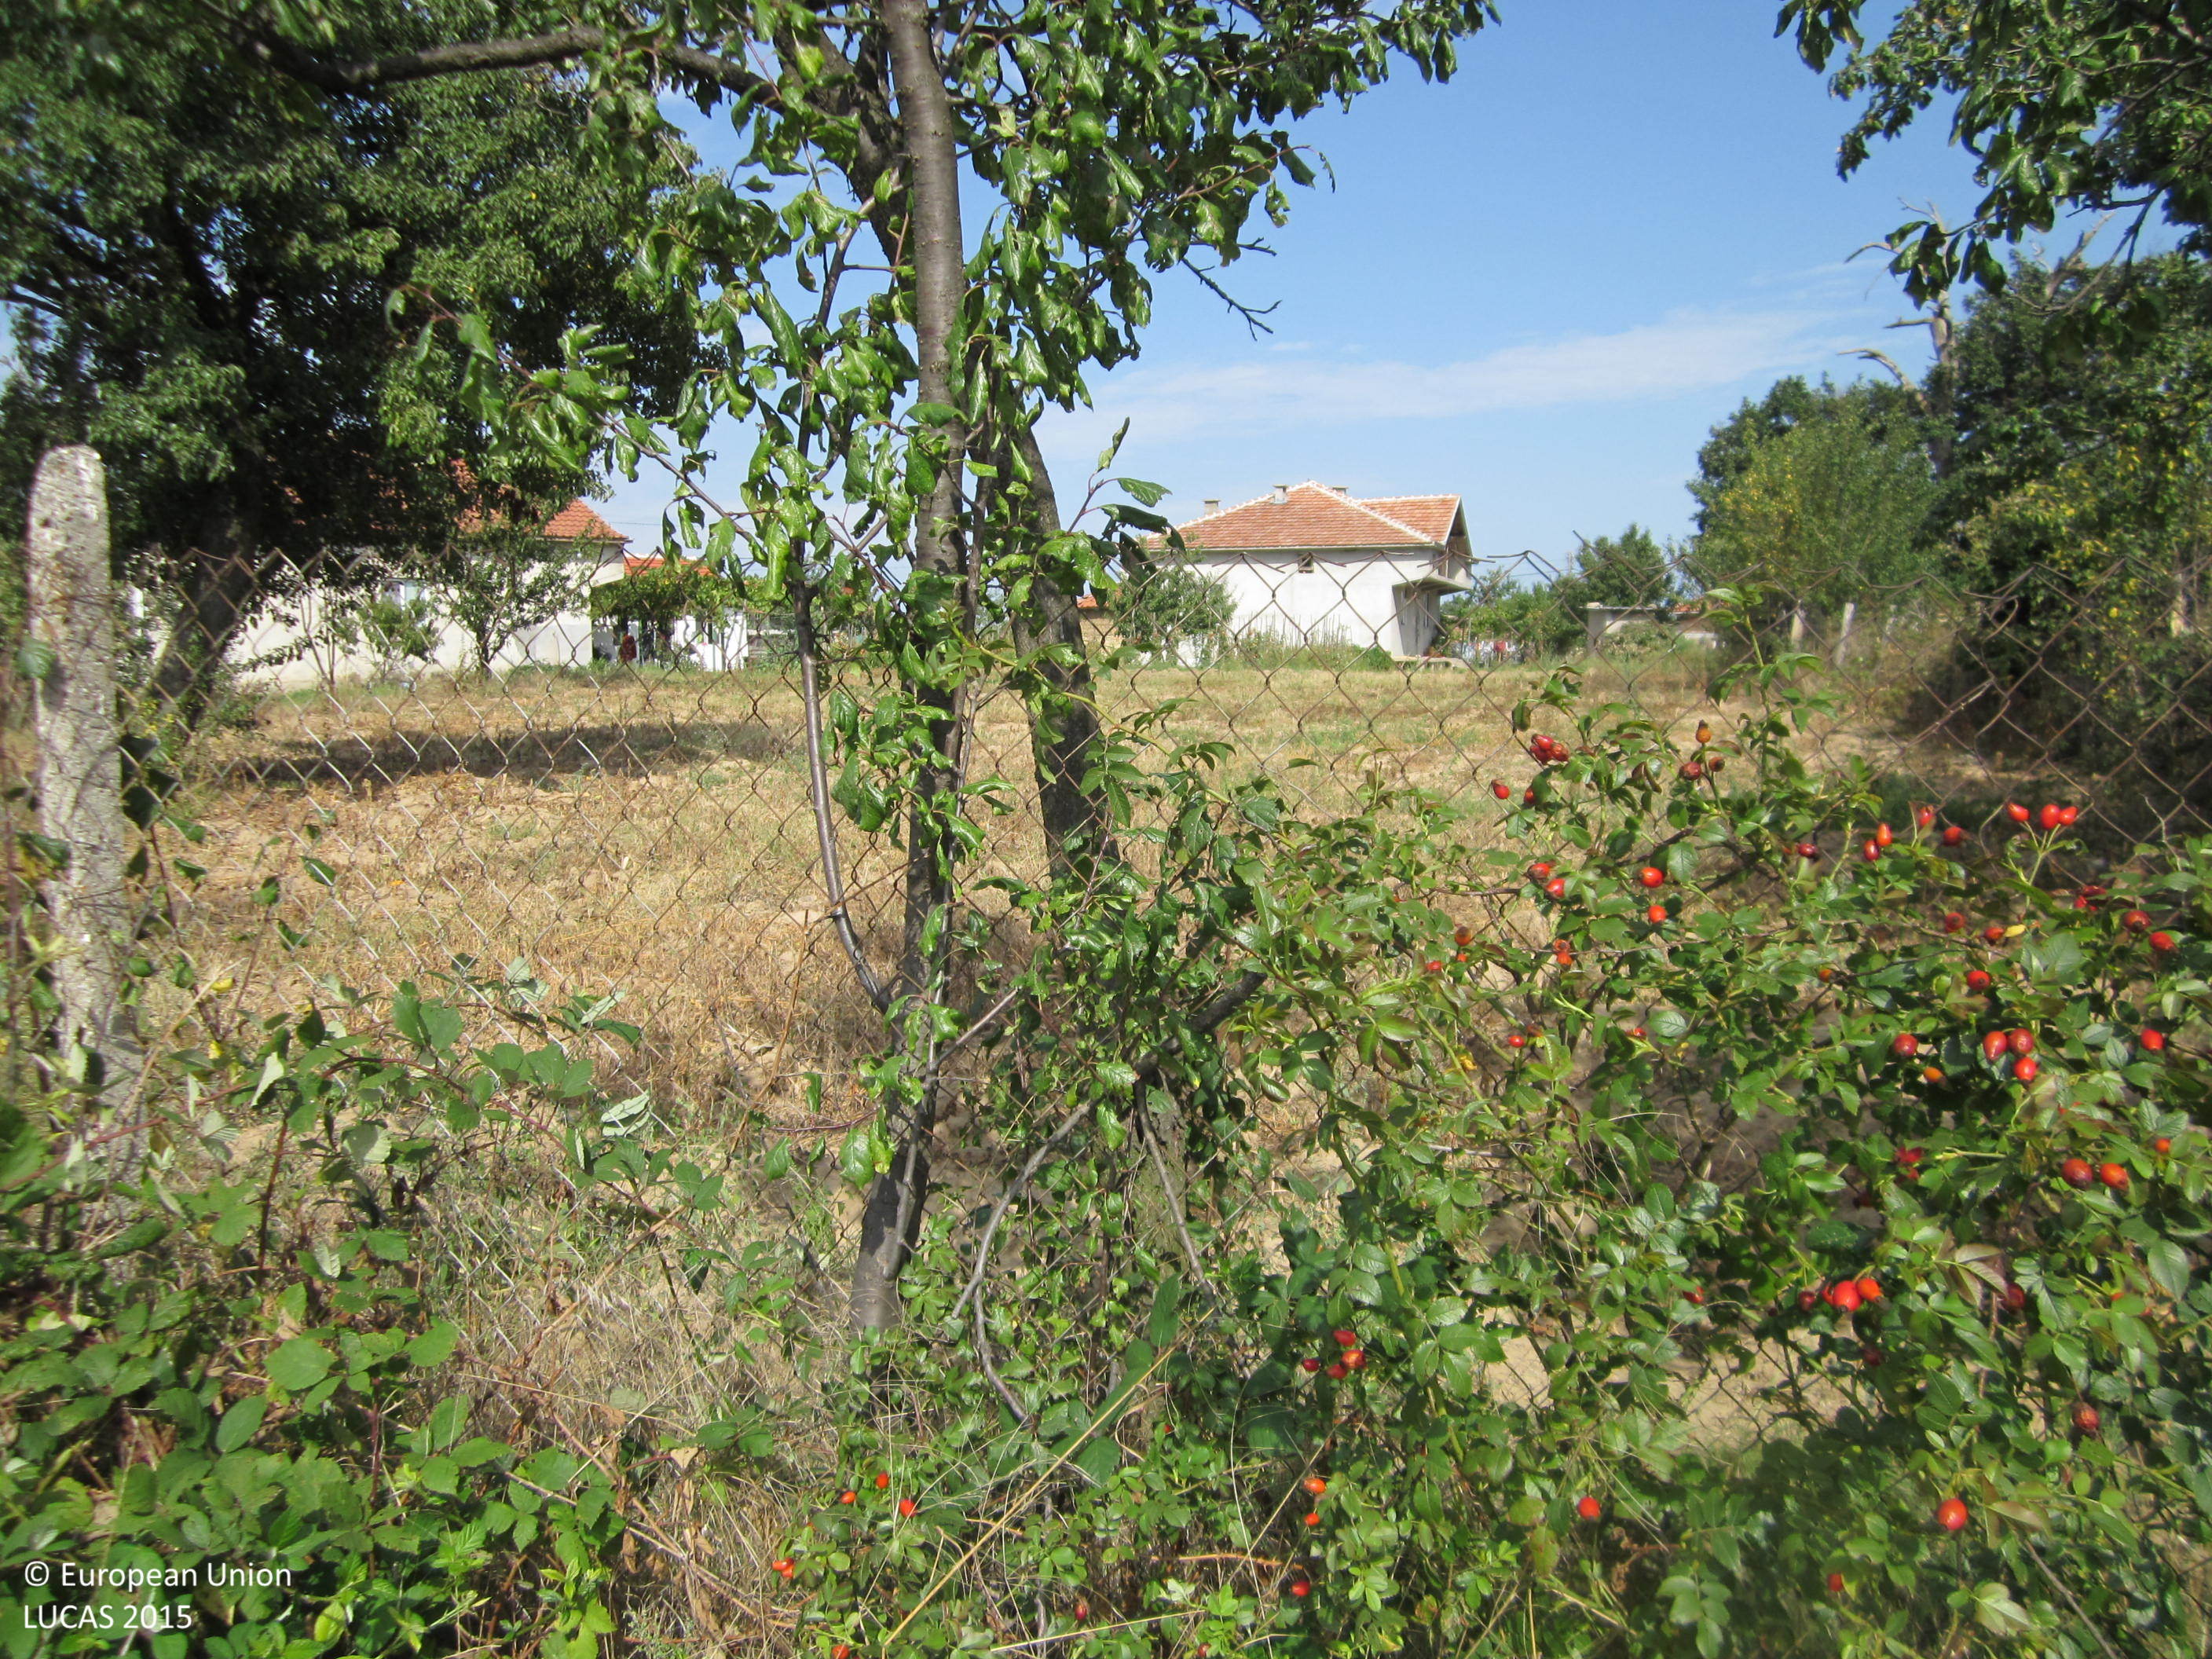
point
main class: Cropland
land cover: Potatoes
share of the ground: 25 - 50 %
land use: Kitchen garden
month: September
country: BG
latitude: 42.7785
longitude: 27.1635
